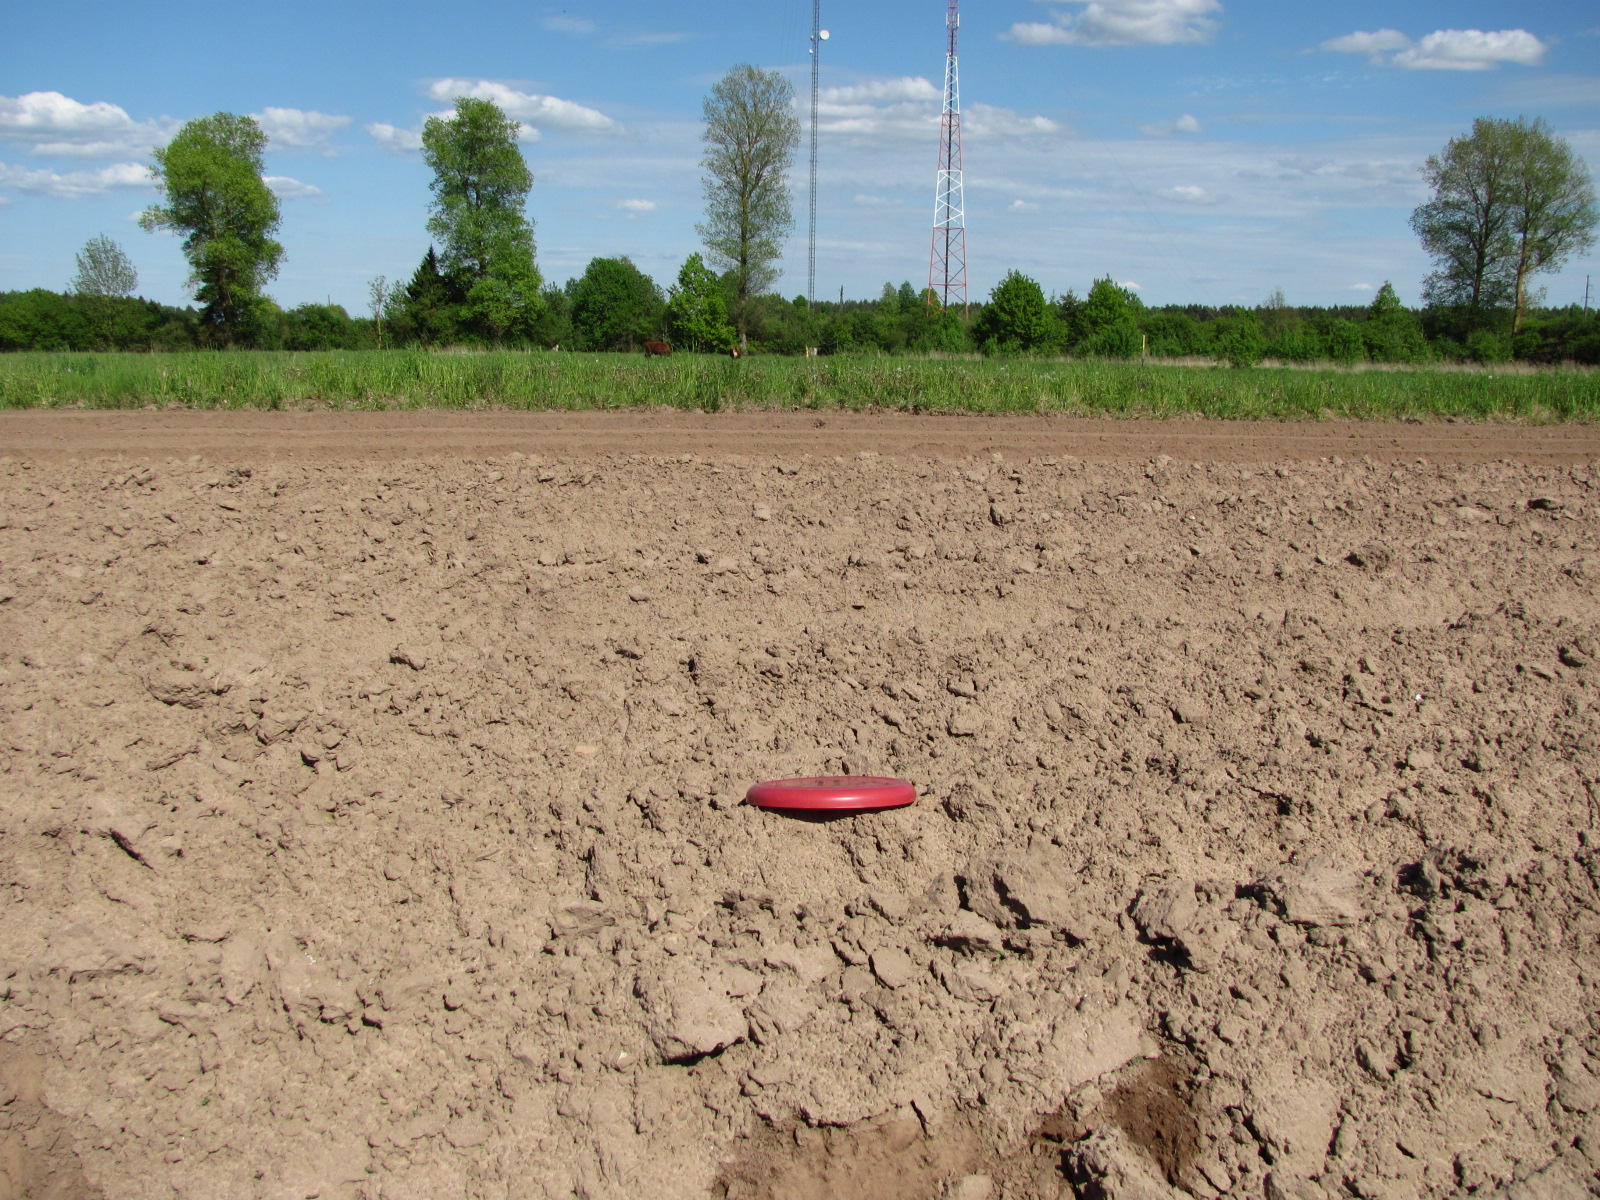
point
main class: Cropland
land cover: Potatoes
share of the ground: < 10 %
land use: Agriculture (excluding fallow land and kitchen gardens)
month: May
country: LV
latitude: 56.6127
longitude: 24.0827
